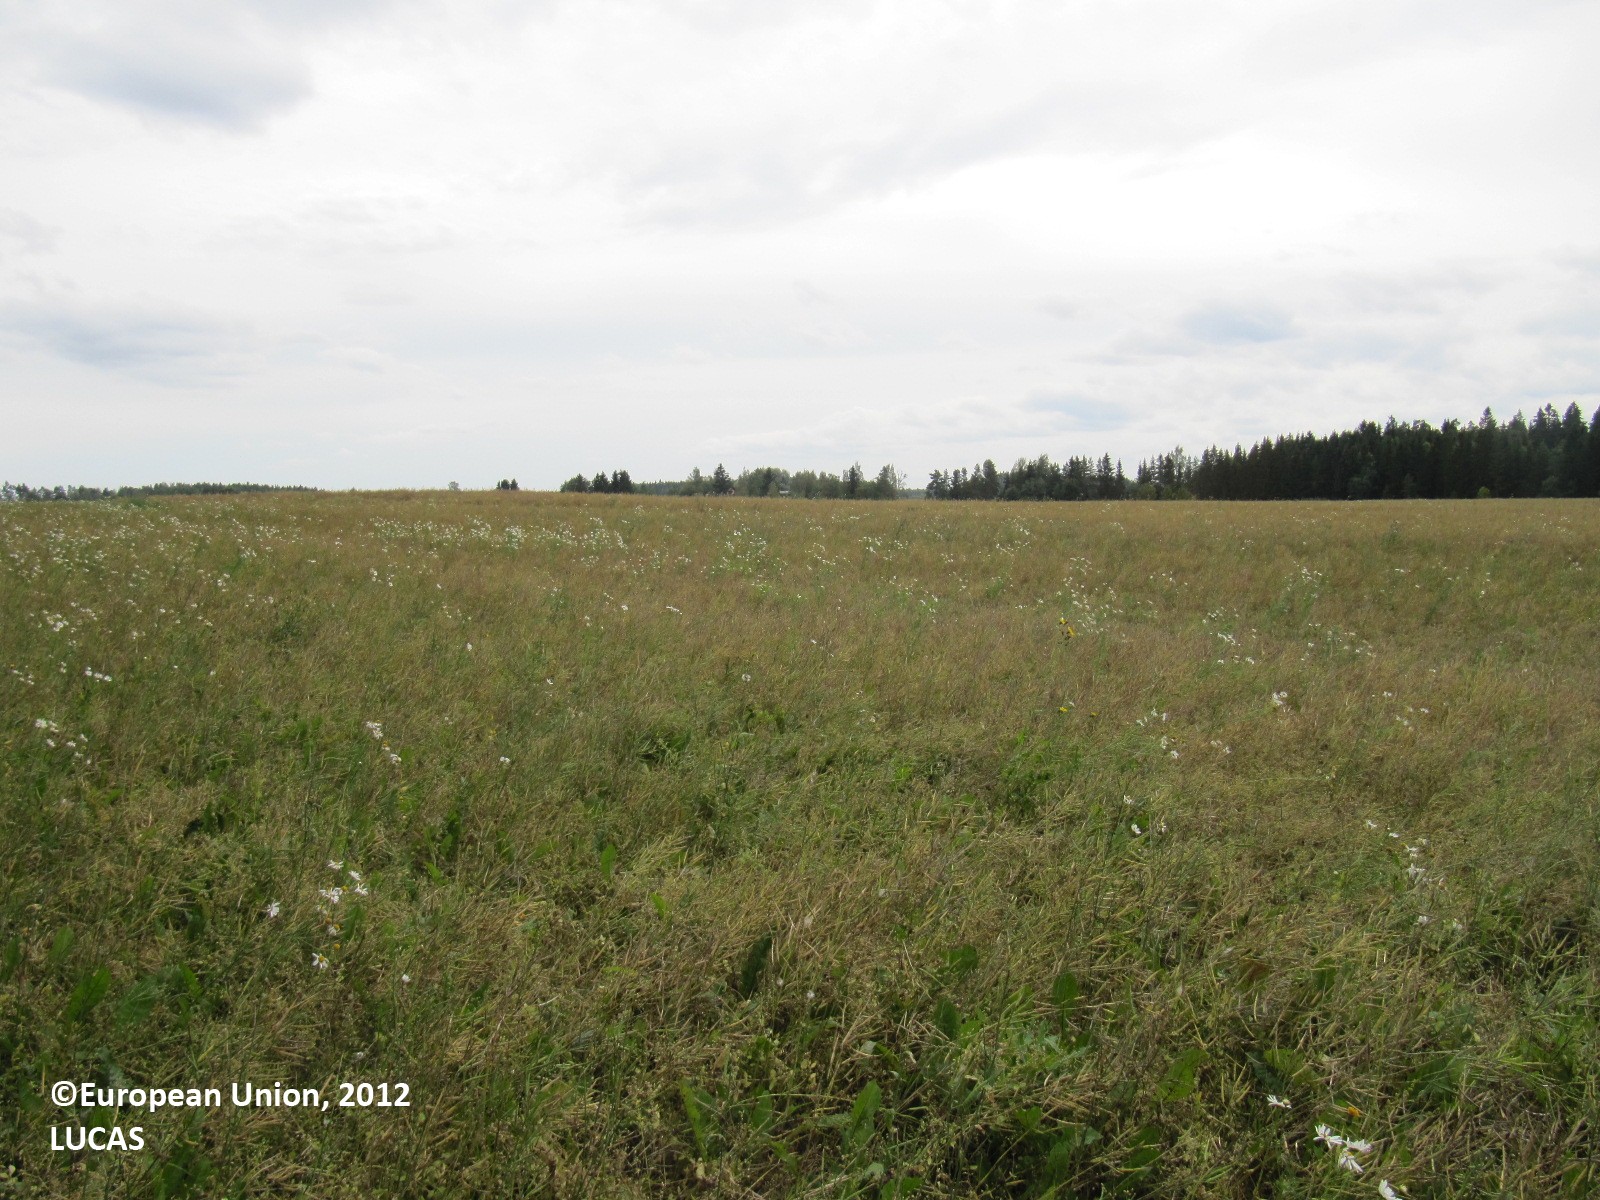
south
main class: Cropland
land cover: Rape and turnip rape
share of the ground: > 75 %
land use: Agriculture (excluding fallow land and kitchen gardens)
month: August
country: FI
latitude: 60.9381
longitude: 22.8997
